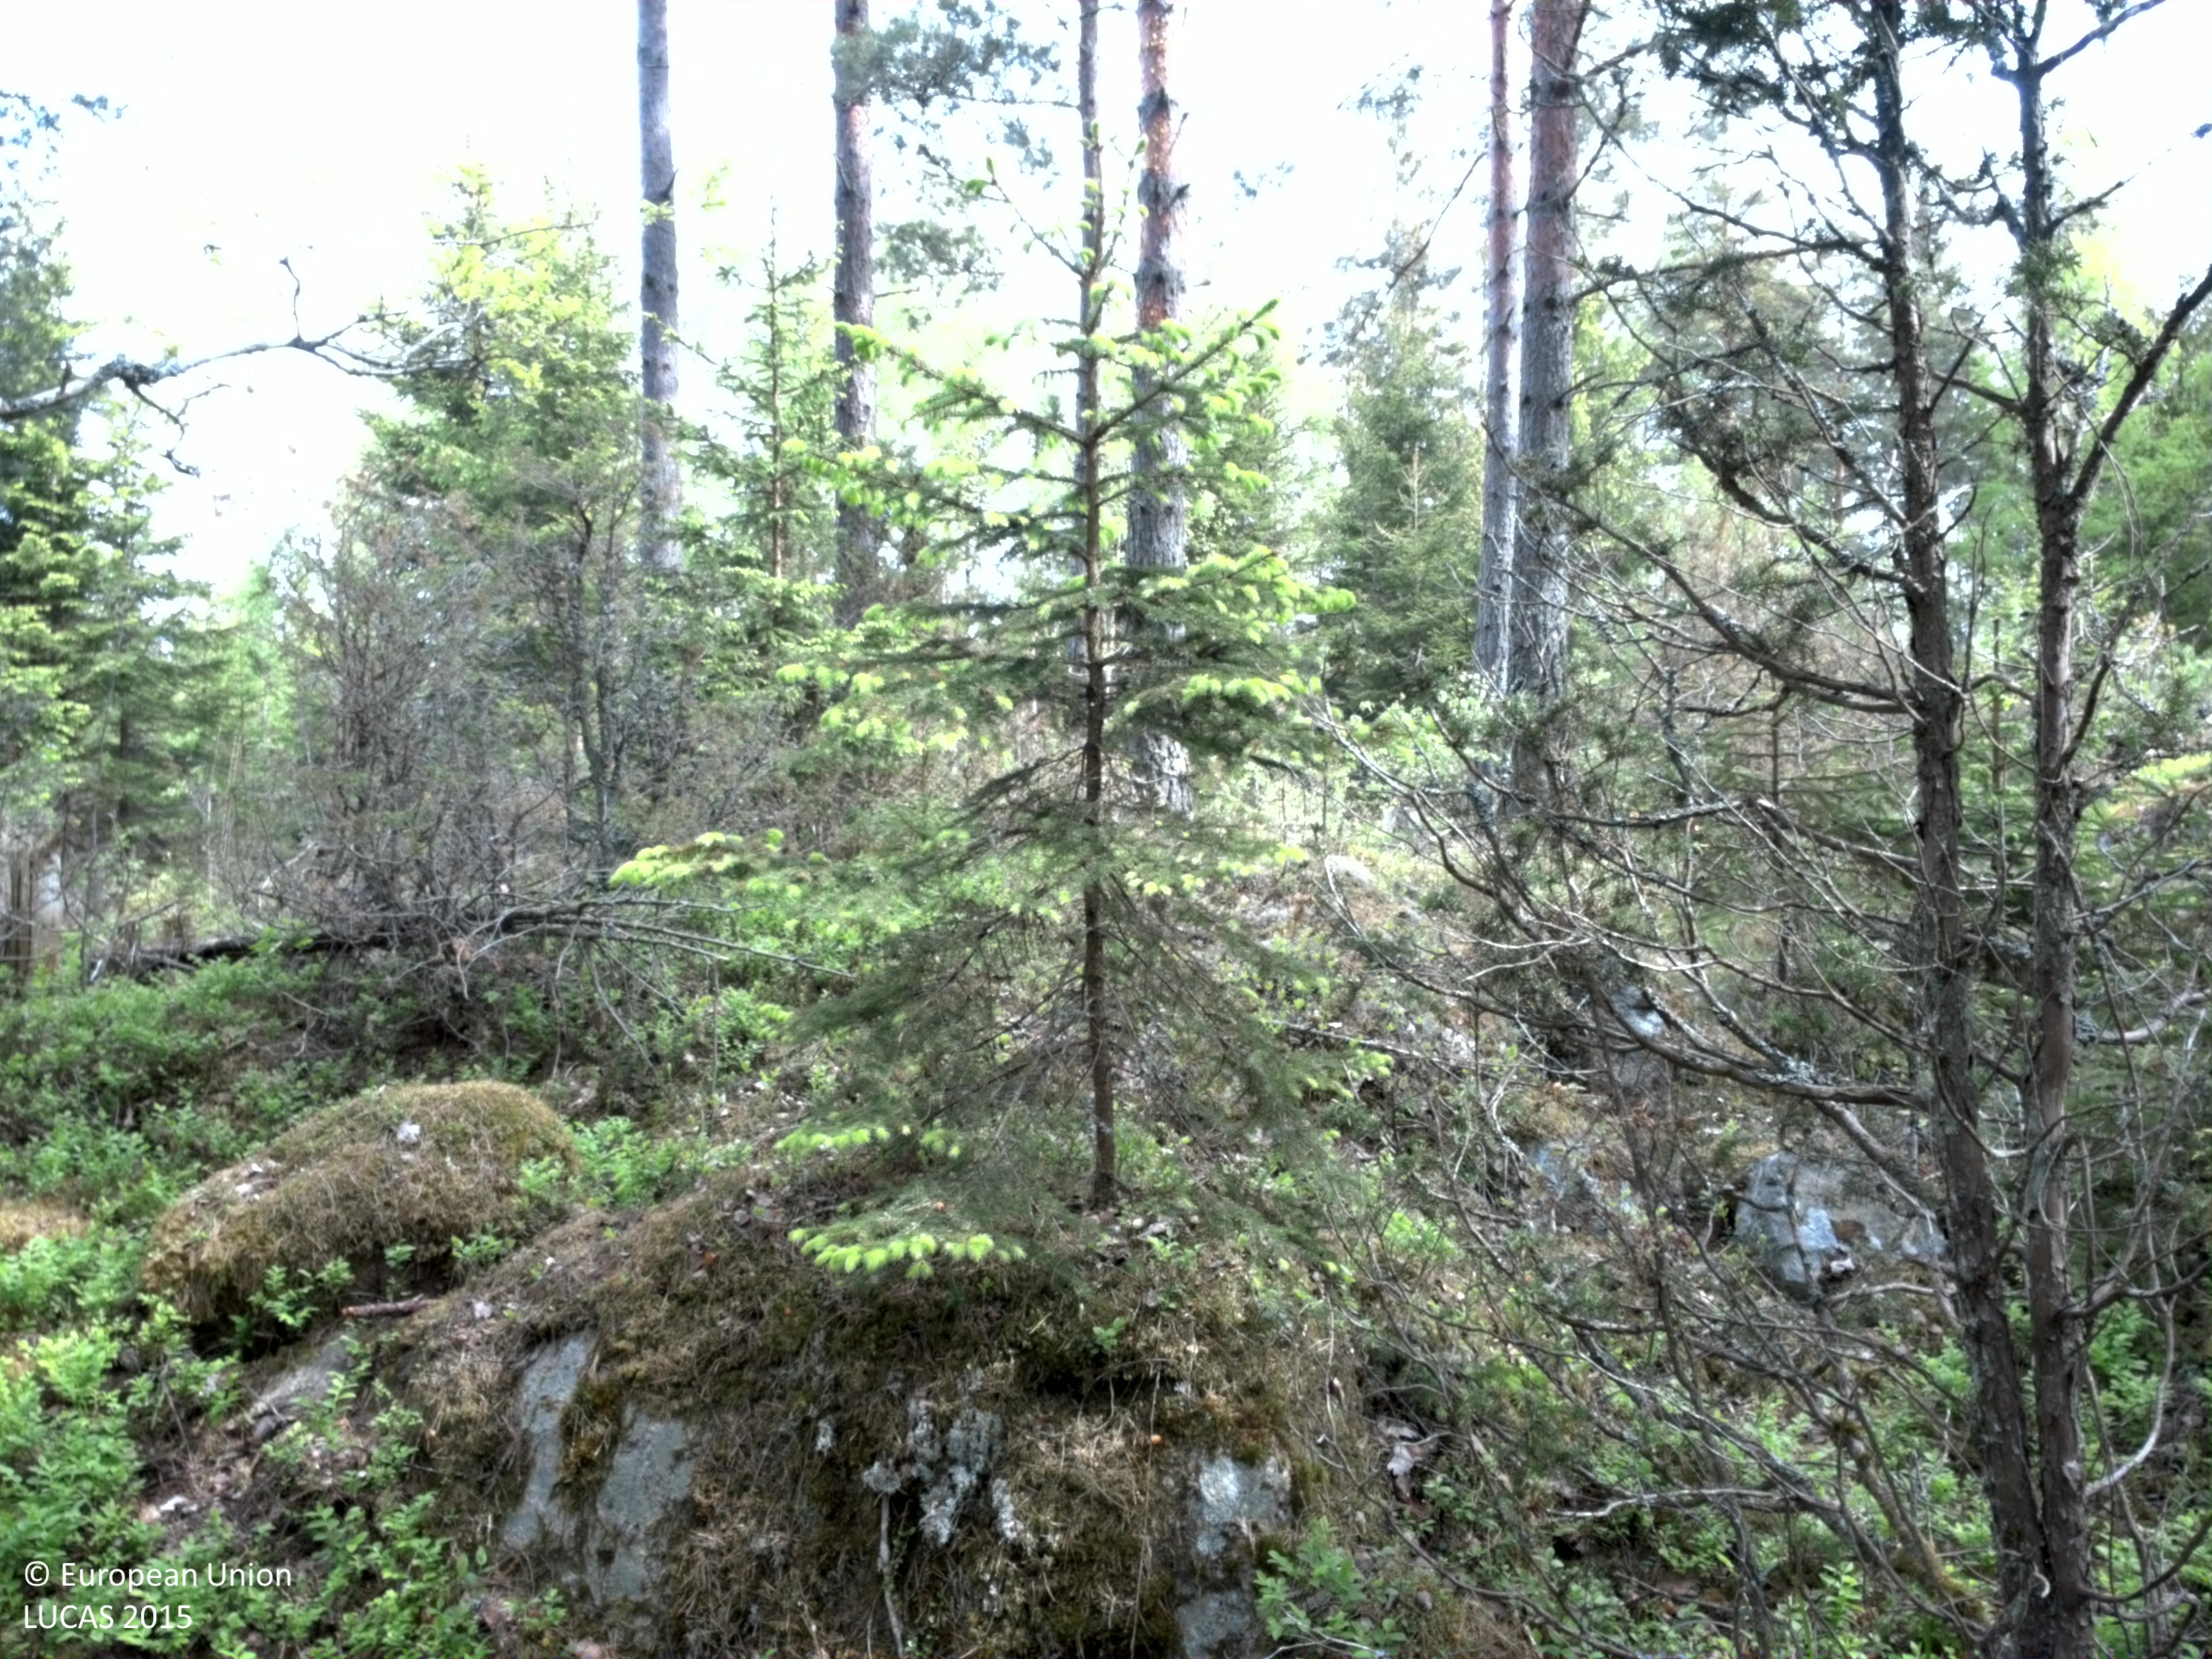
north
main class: Woodland
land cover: Pine dominated mixed woodland
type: boreal forest
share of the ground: 25 - 50 %
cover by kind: coniferous forest trees 25 %, broadleaved forest trees 25 %, shrubs 25 %, lichens and mosses 20 %, herbaceous plants 5 %
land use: Forestry
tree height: > 5 m
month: May
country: SE
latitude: 57.3456
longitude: 15.5973
